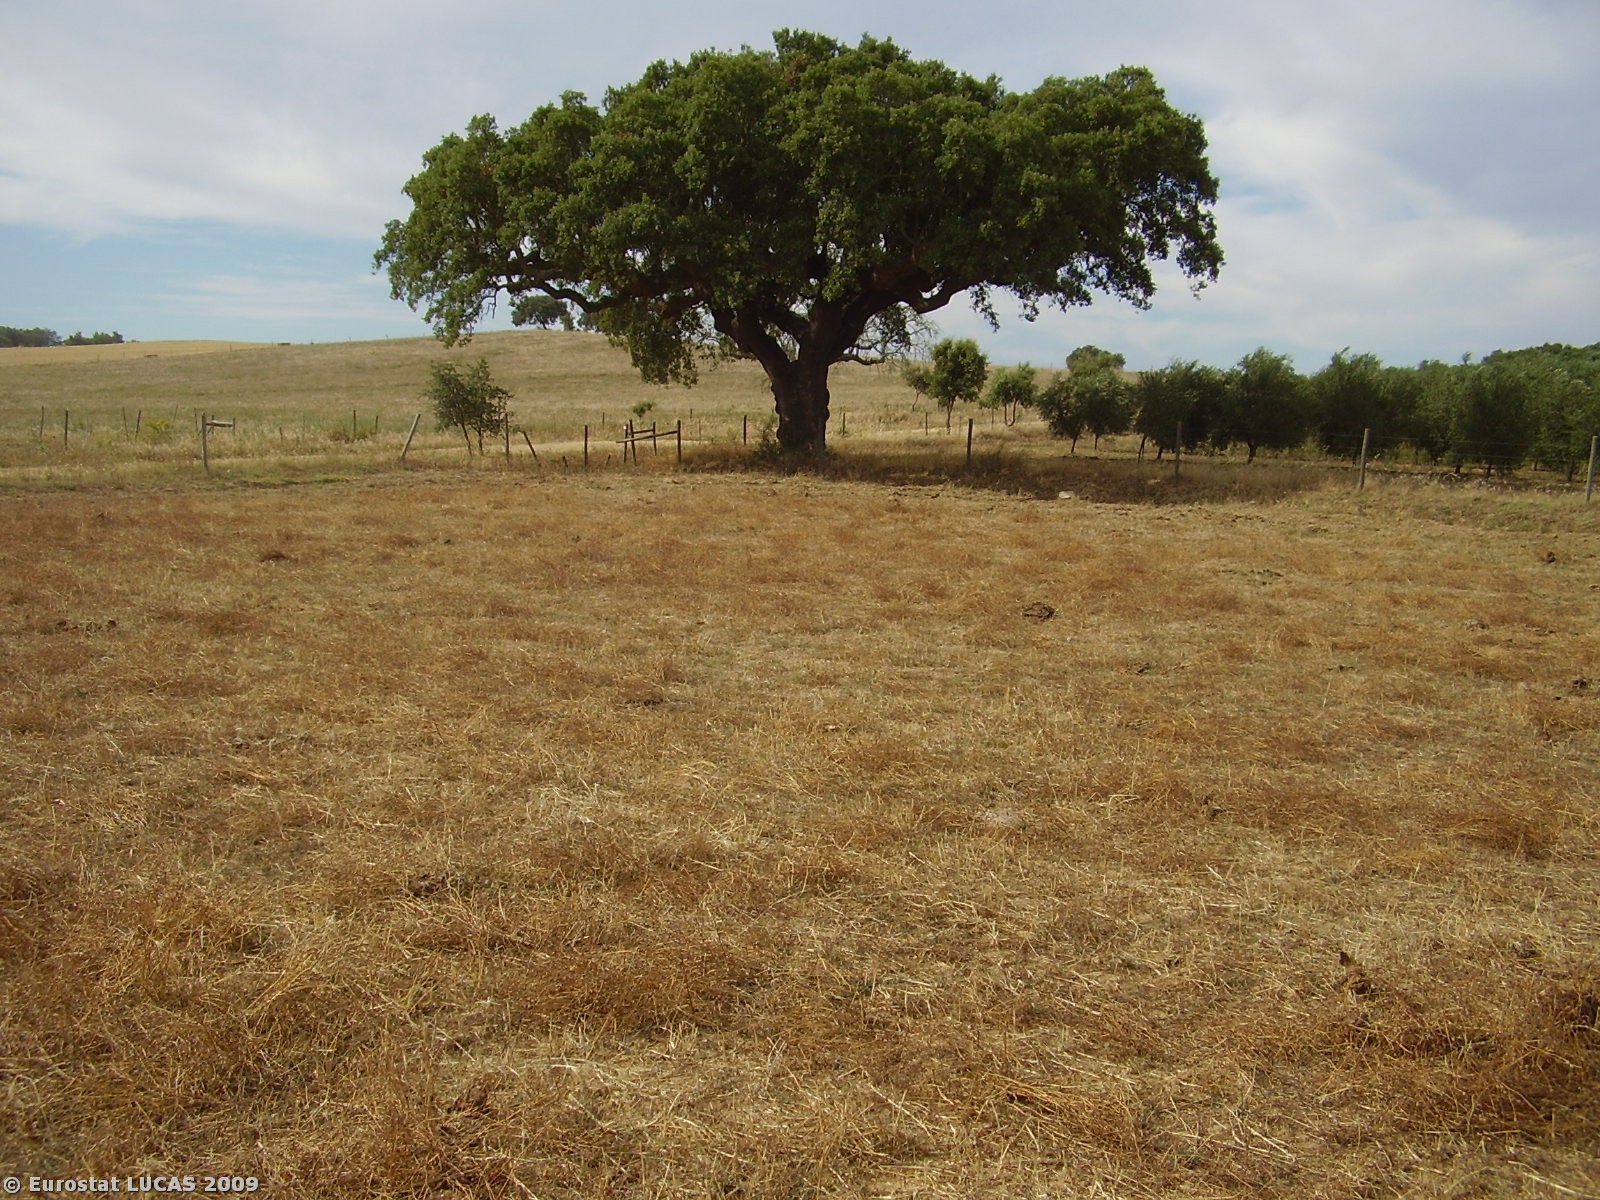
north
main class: Grassland
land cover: Grassland without tree/shrub cover
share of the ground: > 75 %
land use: Agriculture (excluding fallow land and kitchen gardens)
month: July
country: PT
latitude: 38.6895
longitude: -7.8485
